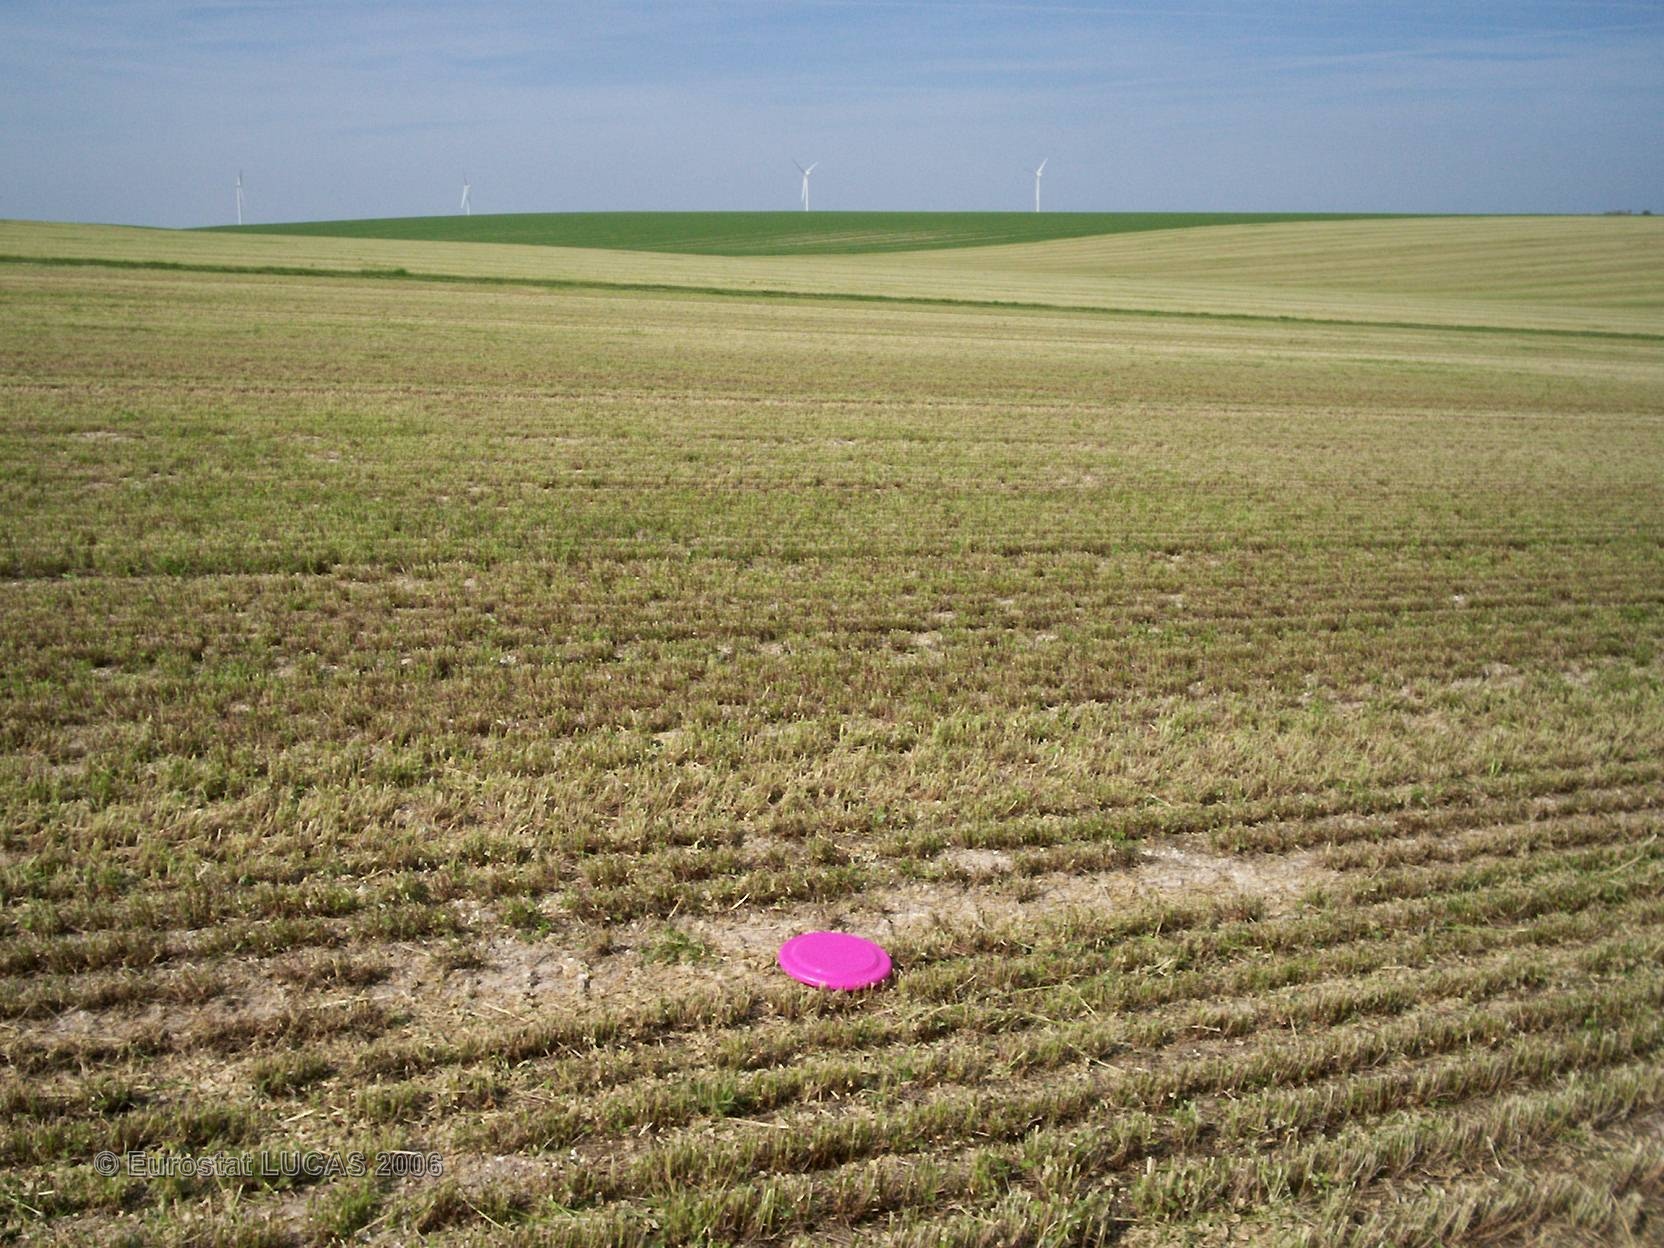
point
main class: Cropland
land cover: Lucerne
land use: Agriculture (excluding fallow land and kitchen gardens)
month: May
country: FR
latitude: 48.8399
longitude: 4.4239
